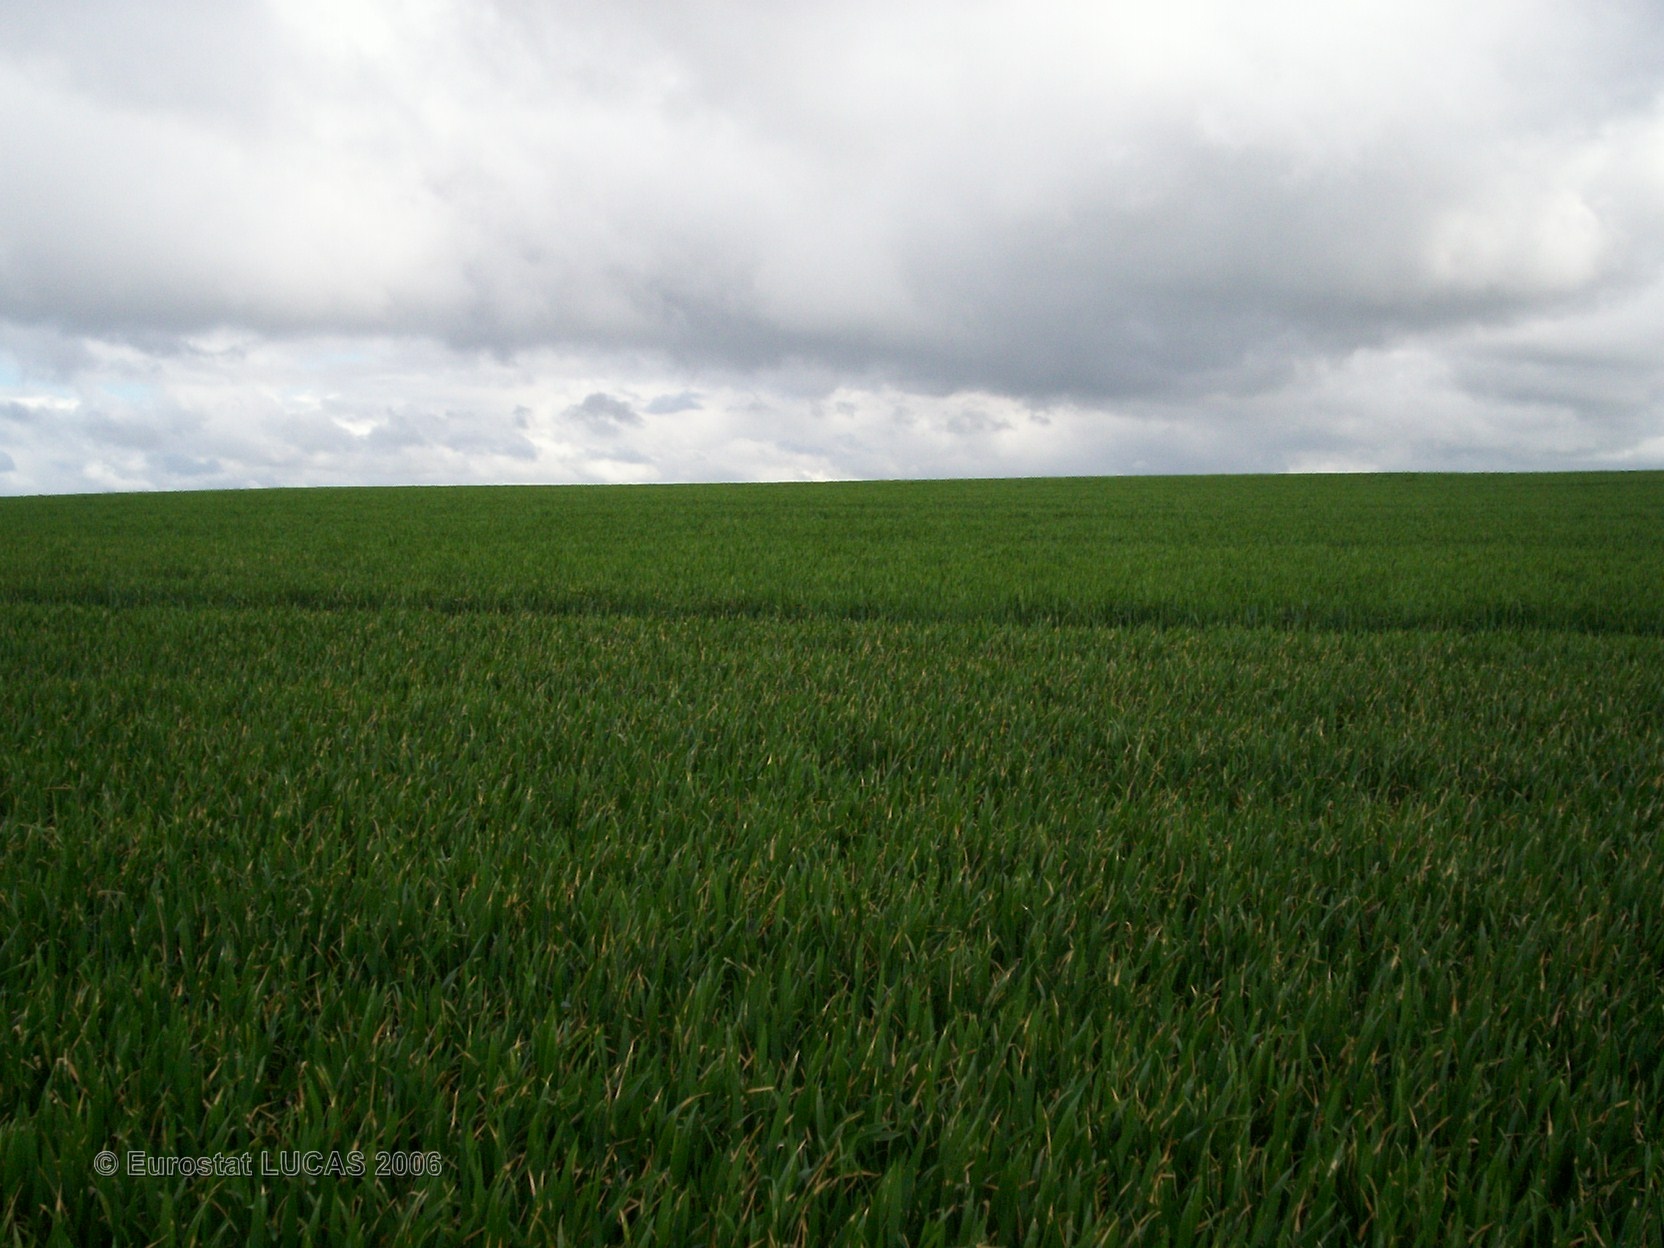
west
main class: Cropland
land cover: Common wheat
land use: Agriculture (excluding fallow land and kitchen gardens)
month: May
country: FR
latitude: 50.1110
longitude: 2.6752
